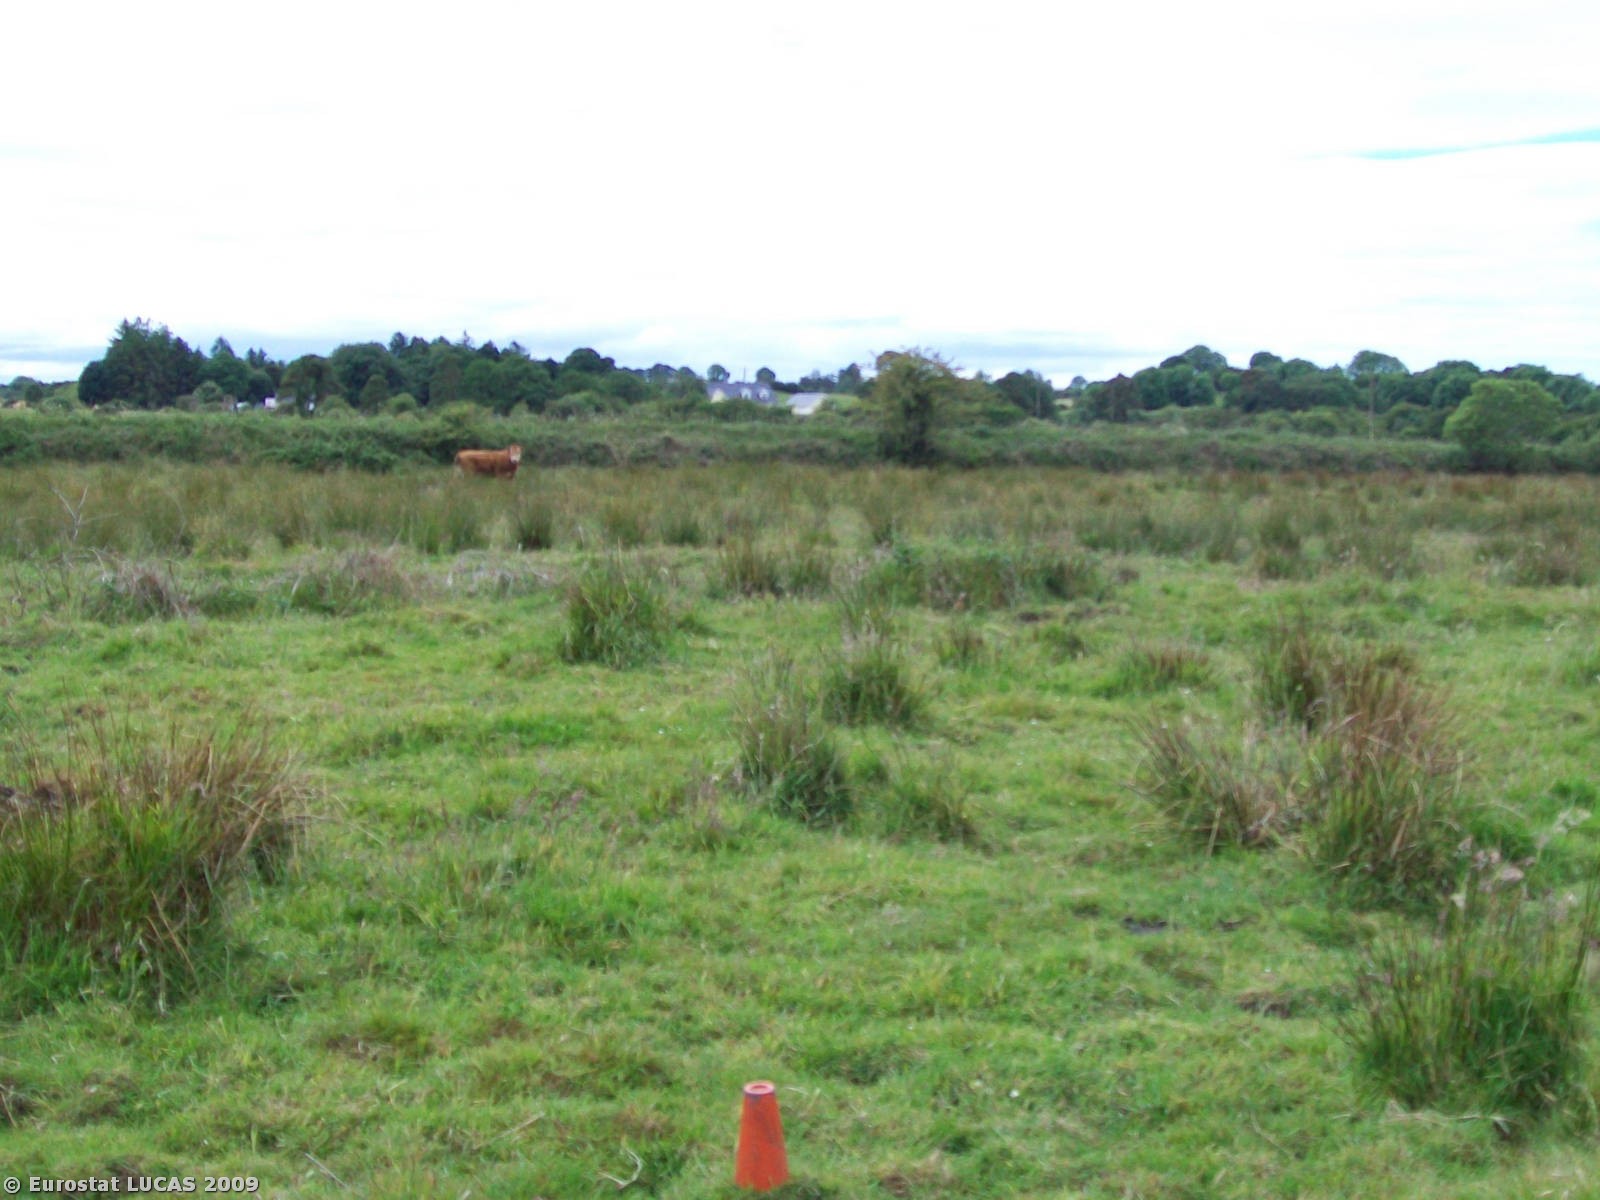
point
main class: Grassland
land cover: Grassland without tree/shrub cover
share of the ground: > 75 %
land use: Agriculture (excluding fallow land and kitchen gardens)
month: June
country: IE
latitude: 53.8153
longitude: -9.0316
